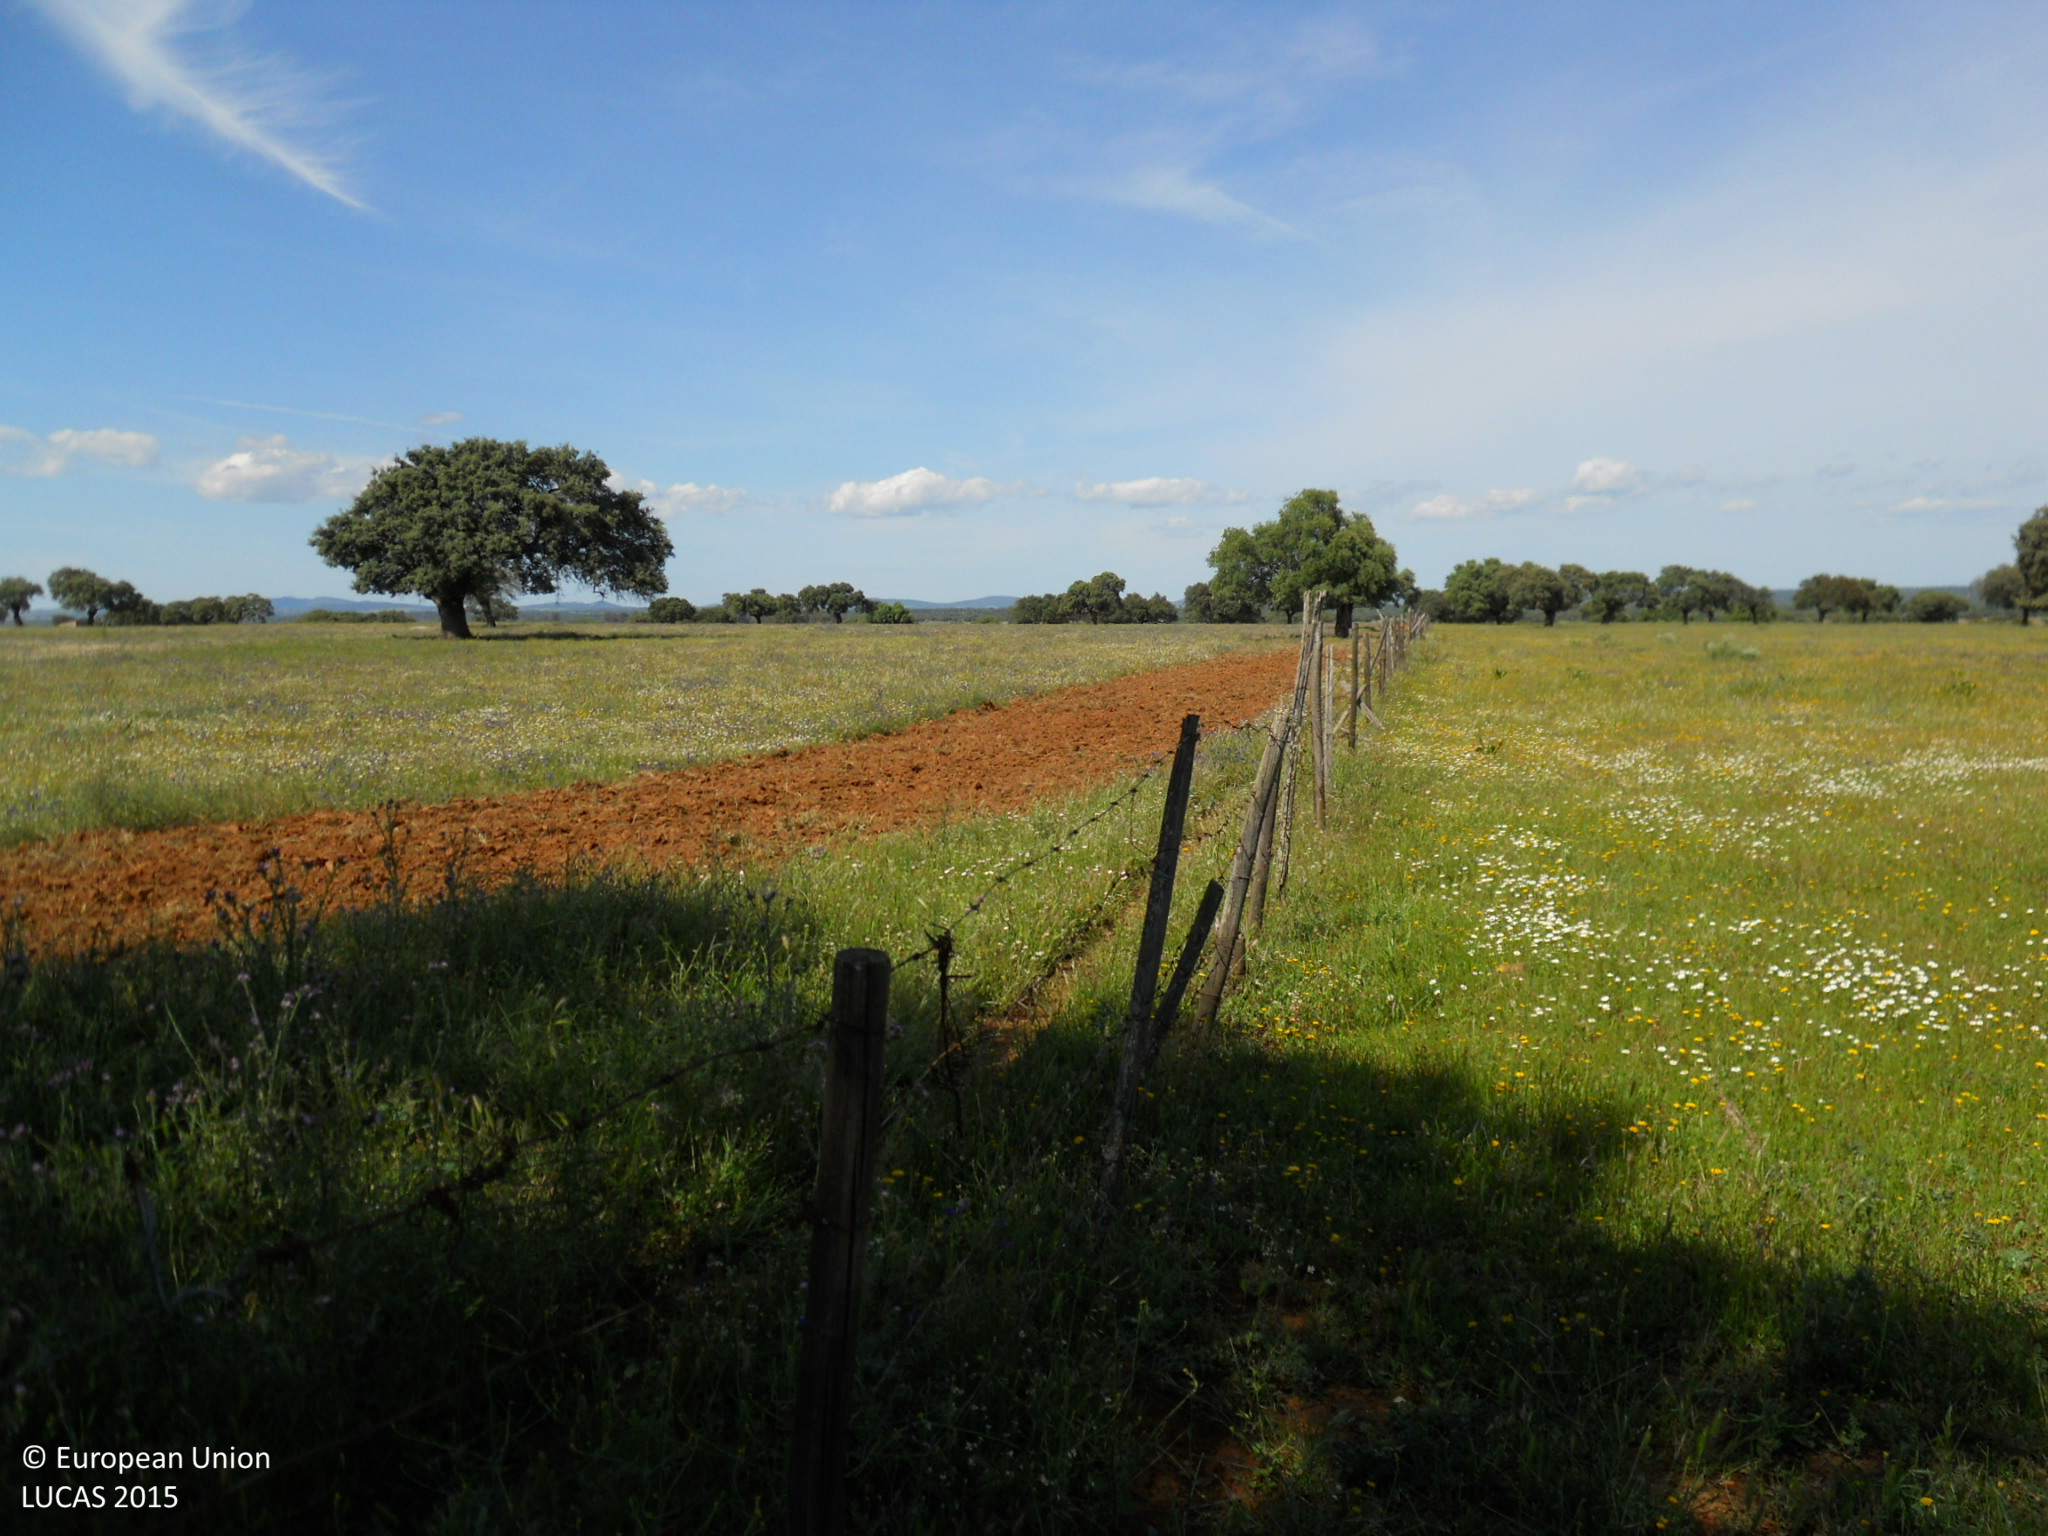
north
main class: Grassland
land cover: Grassland without tree/shrub cover
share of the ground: > 75 %
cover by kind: herbaceous plants 100 %
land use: Agriculture (excluding fallow land and kitchen gardens)
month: April
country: ES
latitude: 39.0031
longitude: -6.9419
